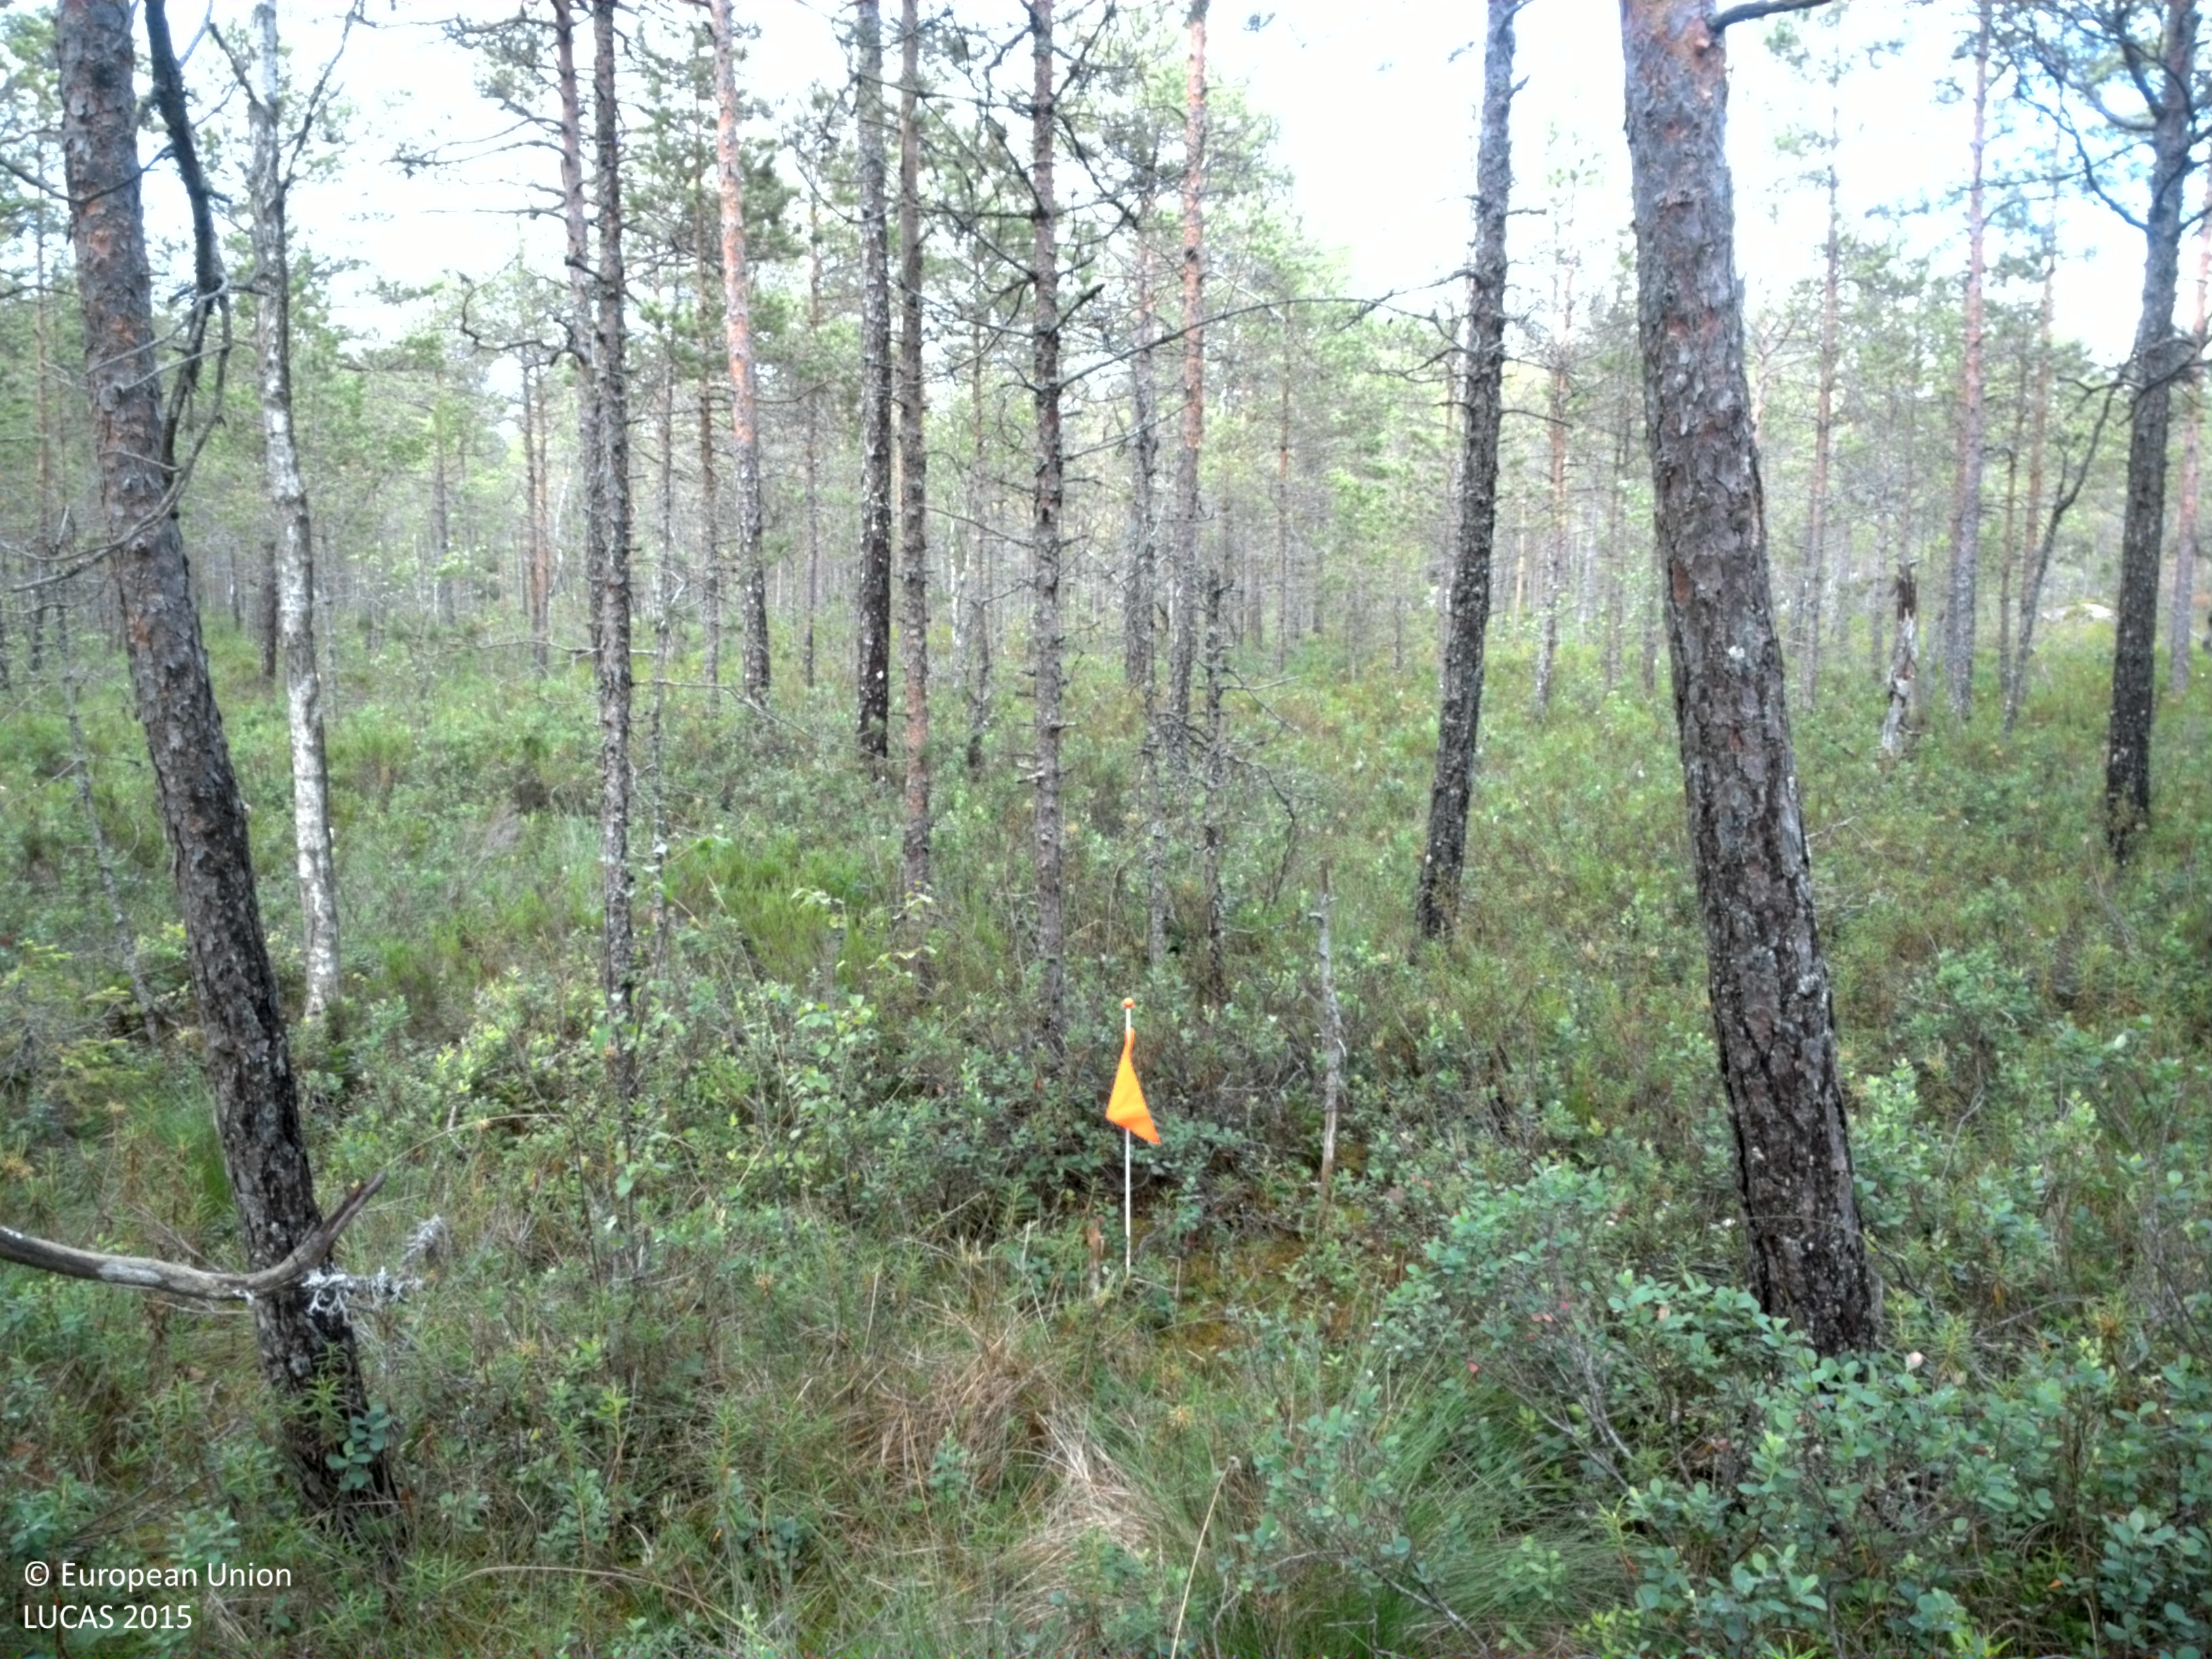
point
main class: Woodland
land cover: Pine dominated mixed woodland
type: mire and swamp forests
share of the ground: 50 - 75 %
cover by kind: coniferous forest trees 50 %, broadleaved forest trees 20 %, shrubs 20 %, herbaceous plants 5 %, lichens and mosses 5 %
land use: Forestry
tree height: > 5 m
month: July
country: SE
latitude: 59.4711
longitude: 14.7033
